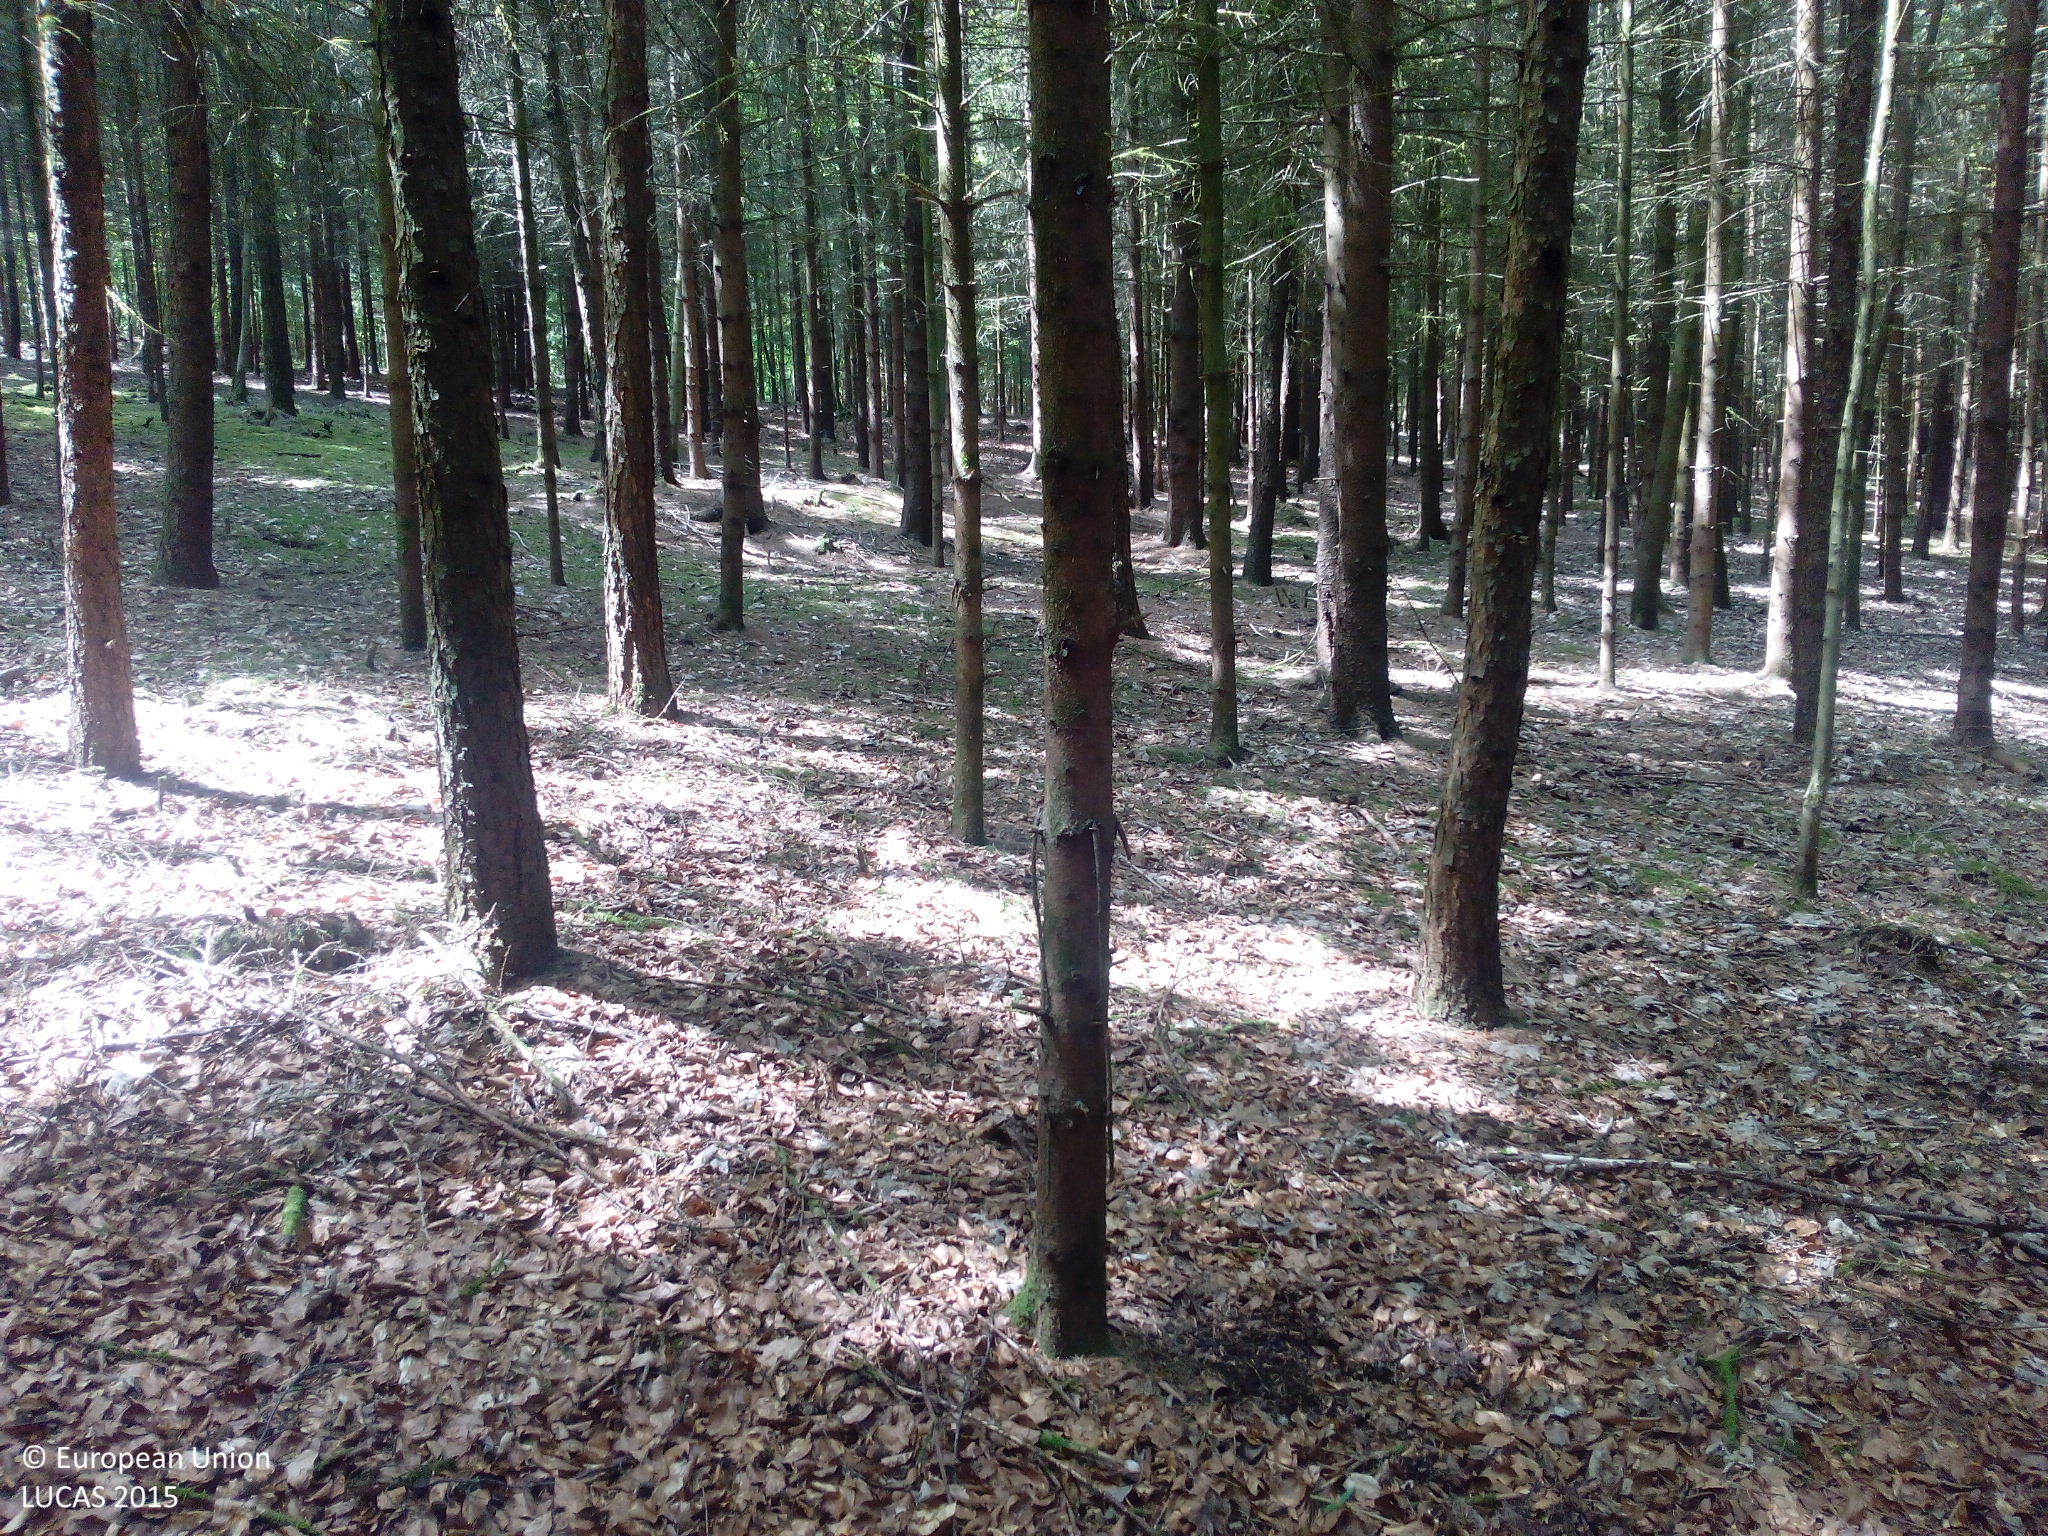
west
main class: Woodland
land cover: Spruce dominated coniferous woodland
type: hemiboreal forest and nemoral coniferous forest and mixed broadleaved-coniferous forest
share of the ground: > 75 %
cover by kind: coniferous forest trees 100 %
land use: Forestry
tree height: > 5 m
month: May
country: DE
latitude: 50.0713
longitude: 11.0755
